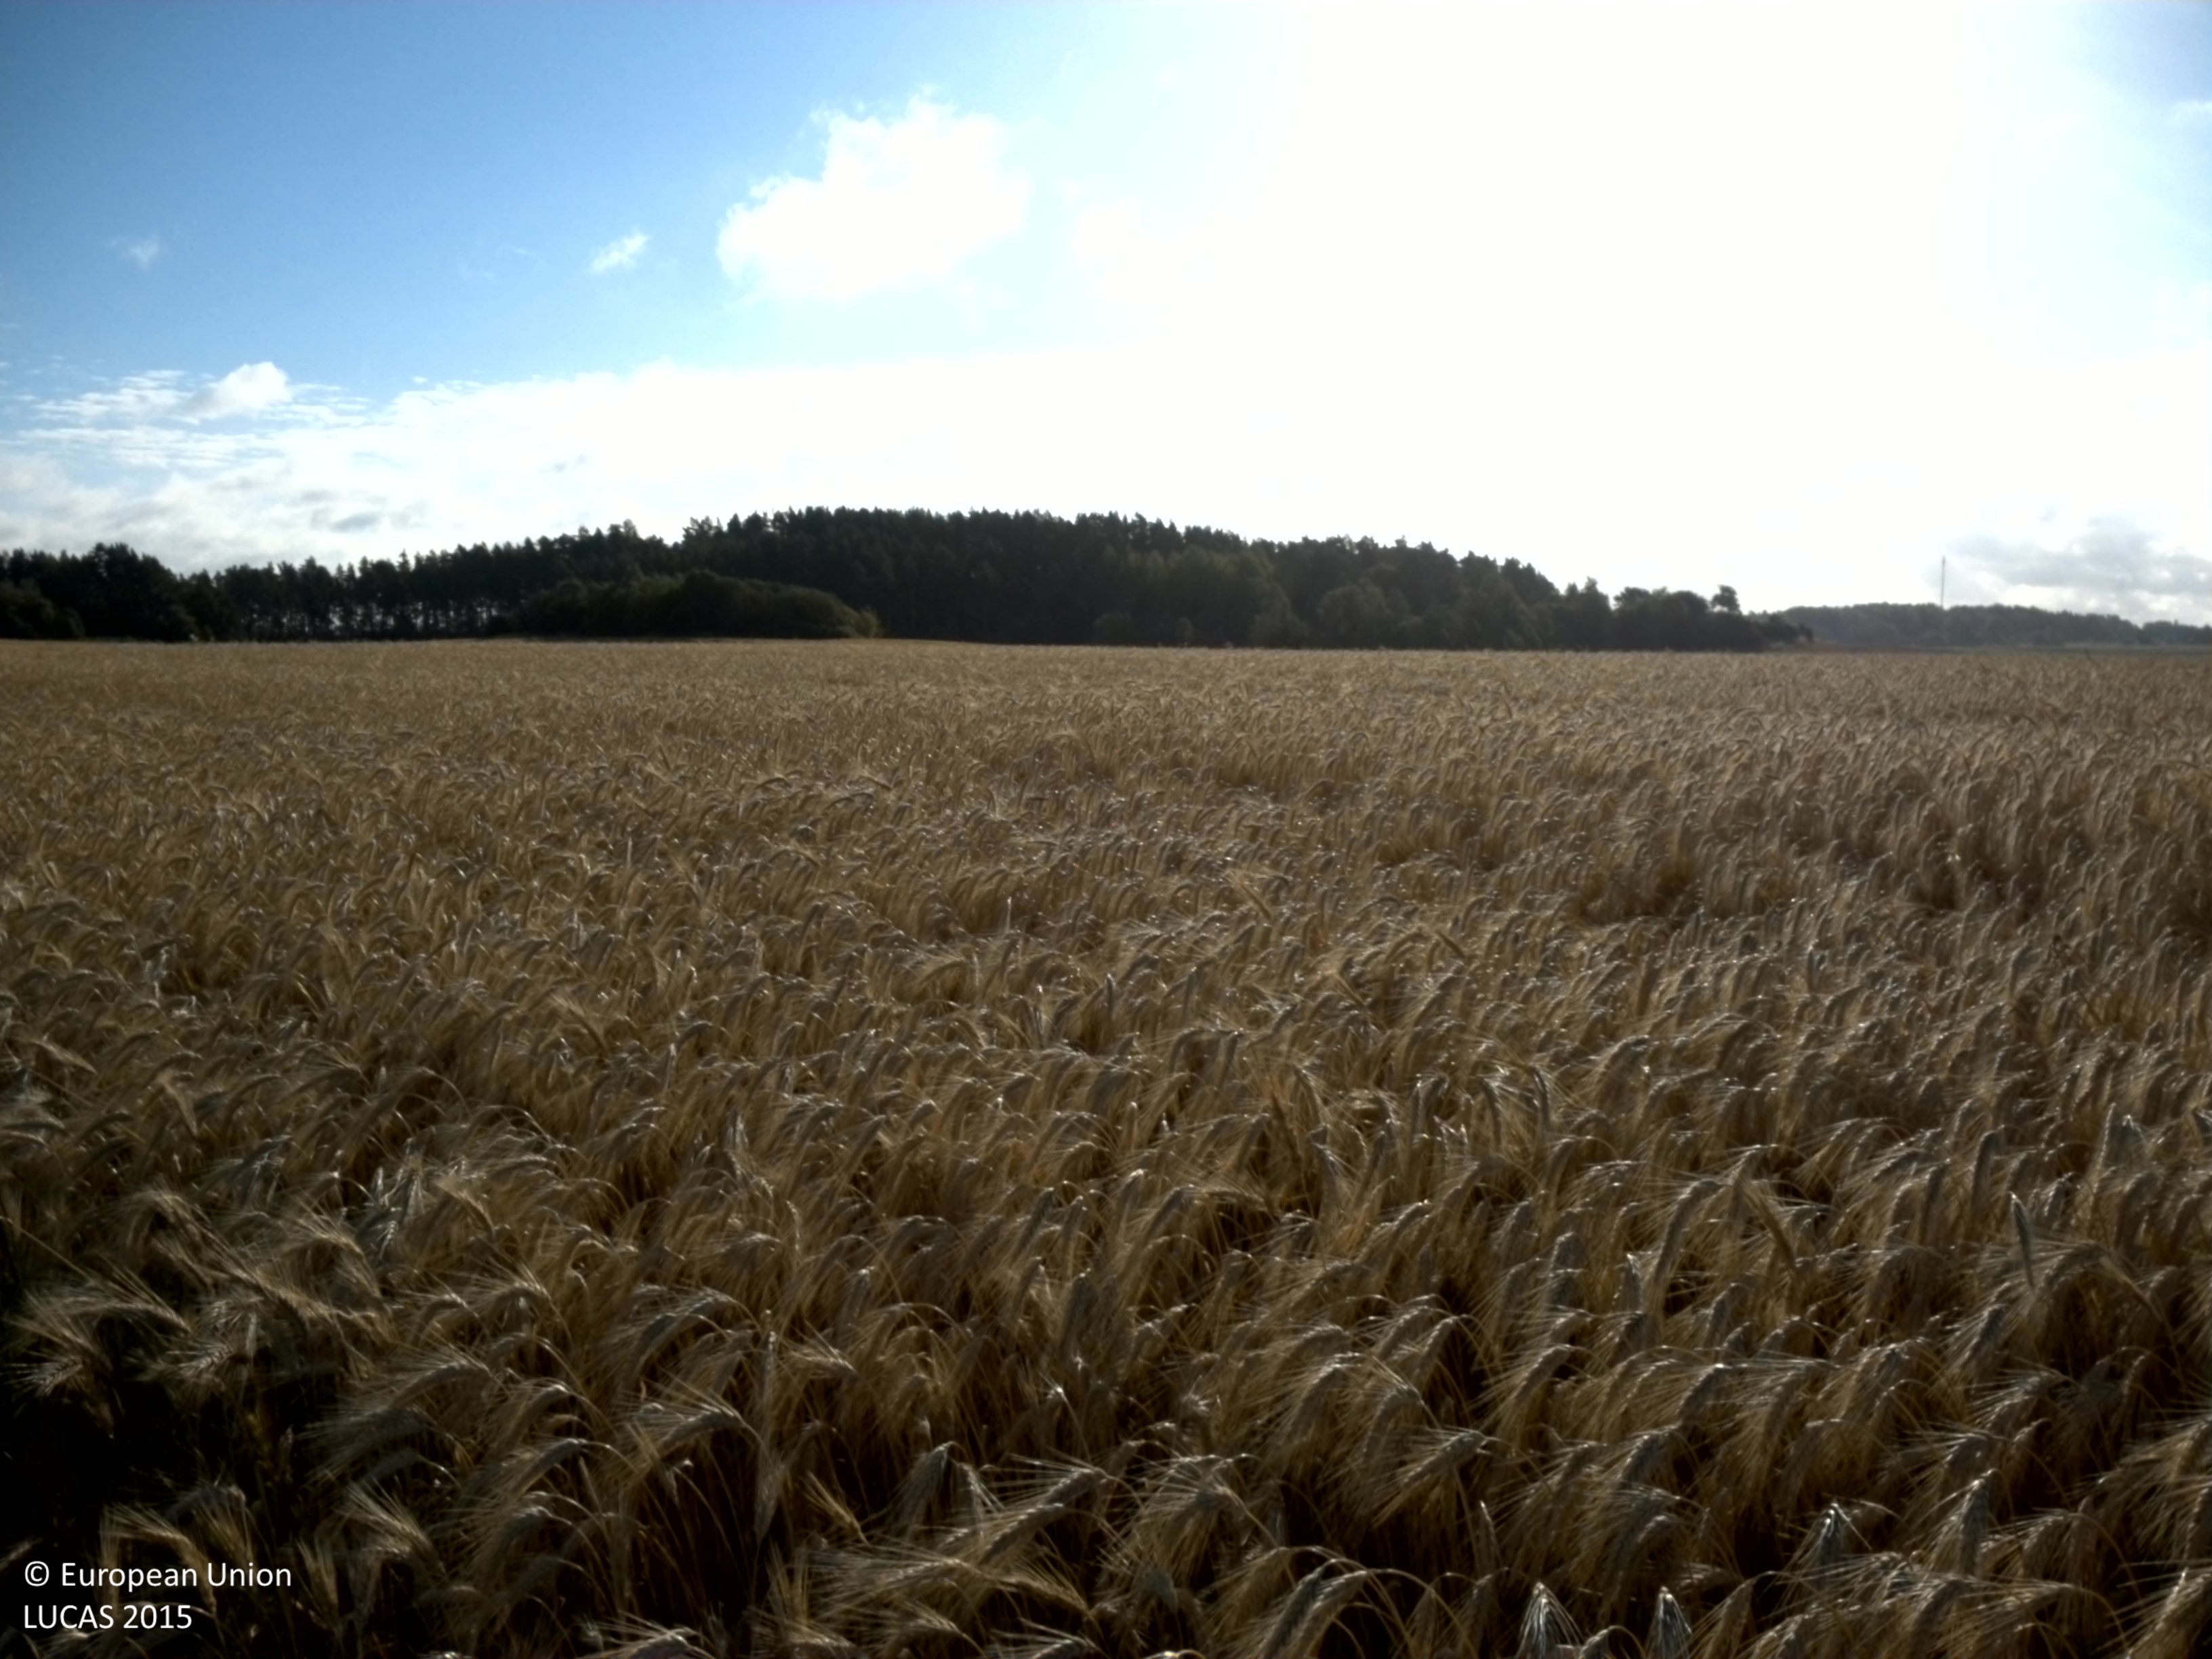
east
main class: Cropland
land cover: Rye
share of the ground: > 75 %
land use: Agriculture (excluding fallow land and kitchen gardens)
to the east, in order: Rye; Grass margins; Ditches and canals; Grass margins; Rye
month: August
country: SE
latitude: 59.7311
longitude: 17.0897
